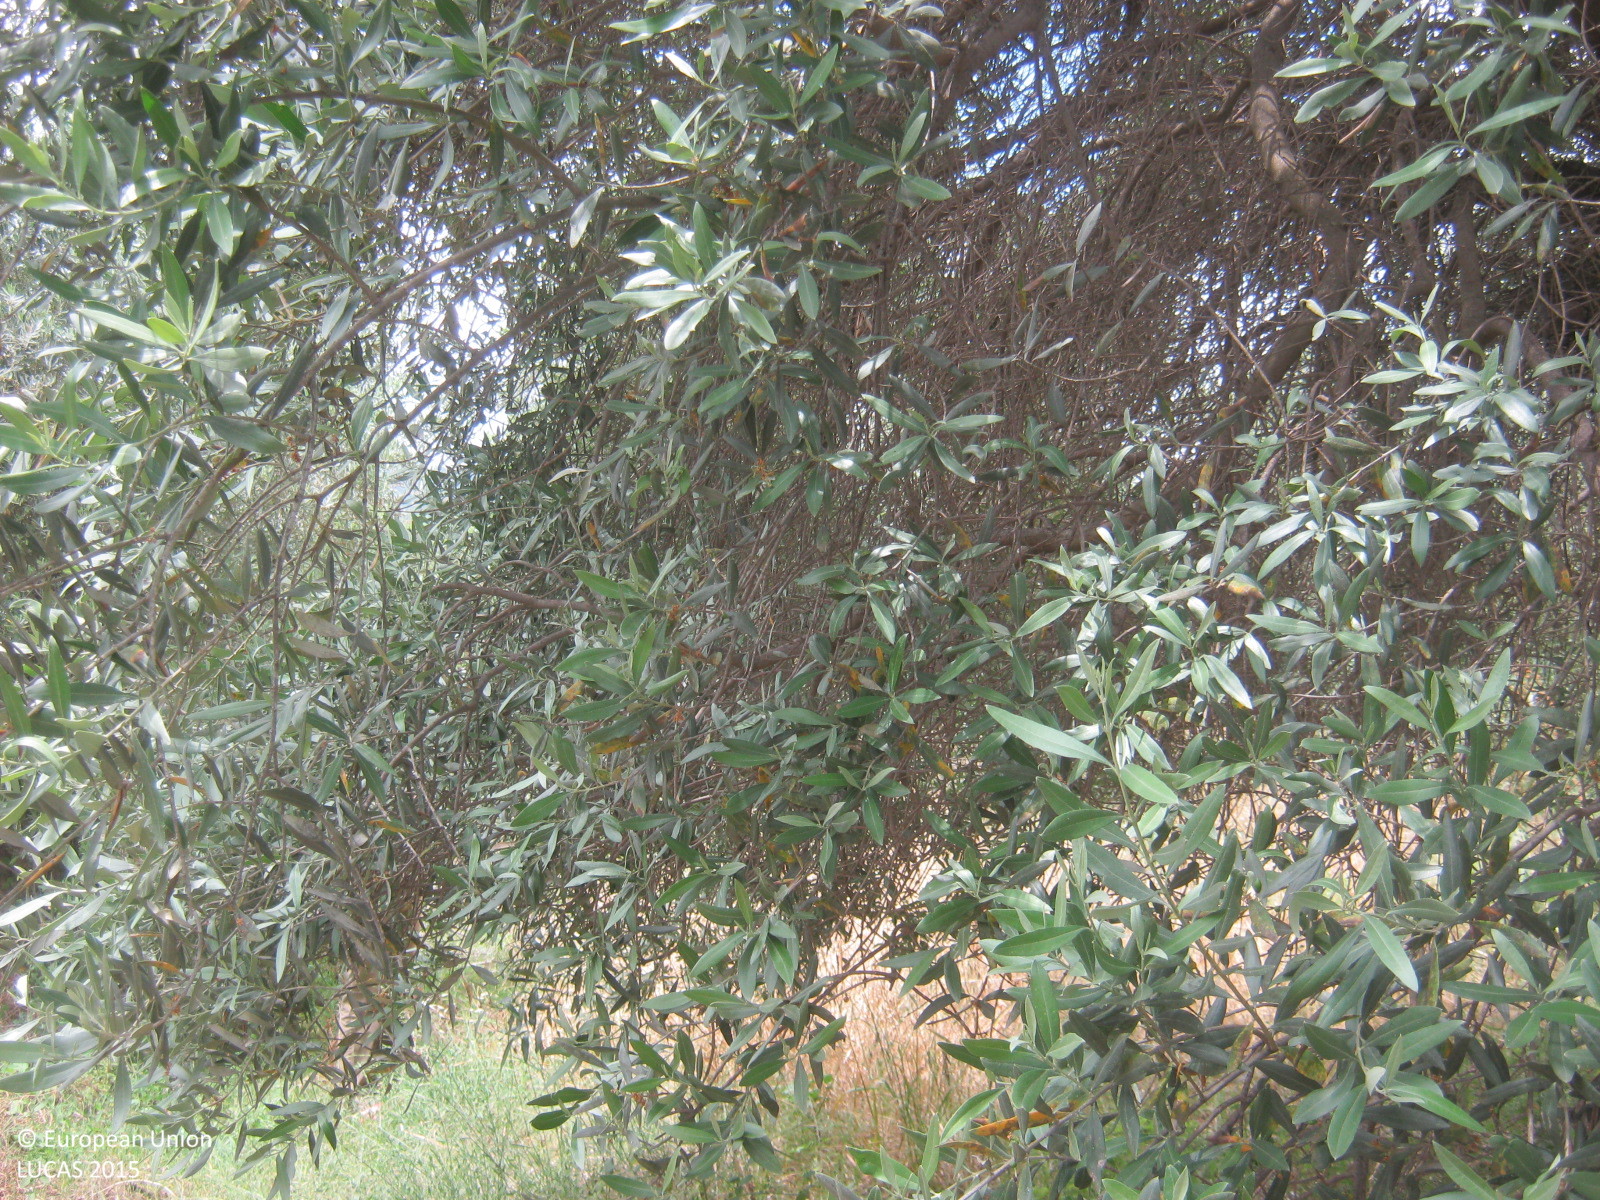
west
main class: Cropland
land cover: Olive groves
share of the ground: 50 - 75 %
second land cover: Grassland without tree/shrub cover
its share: > 75 %
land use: Abandoned areas
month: June
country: CY
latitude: 35.0452
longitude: 32.8972
